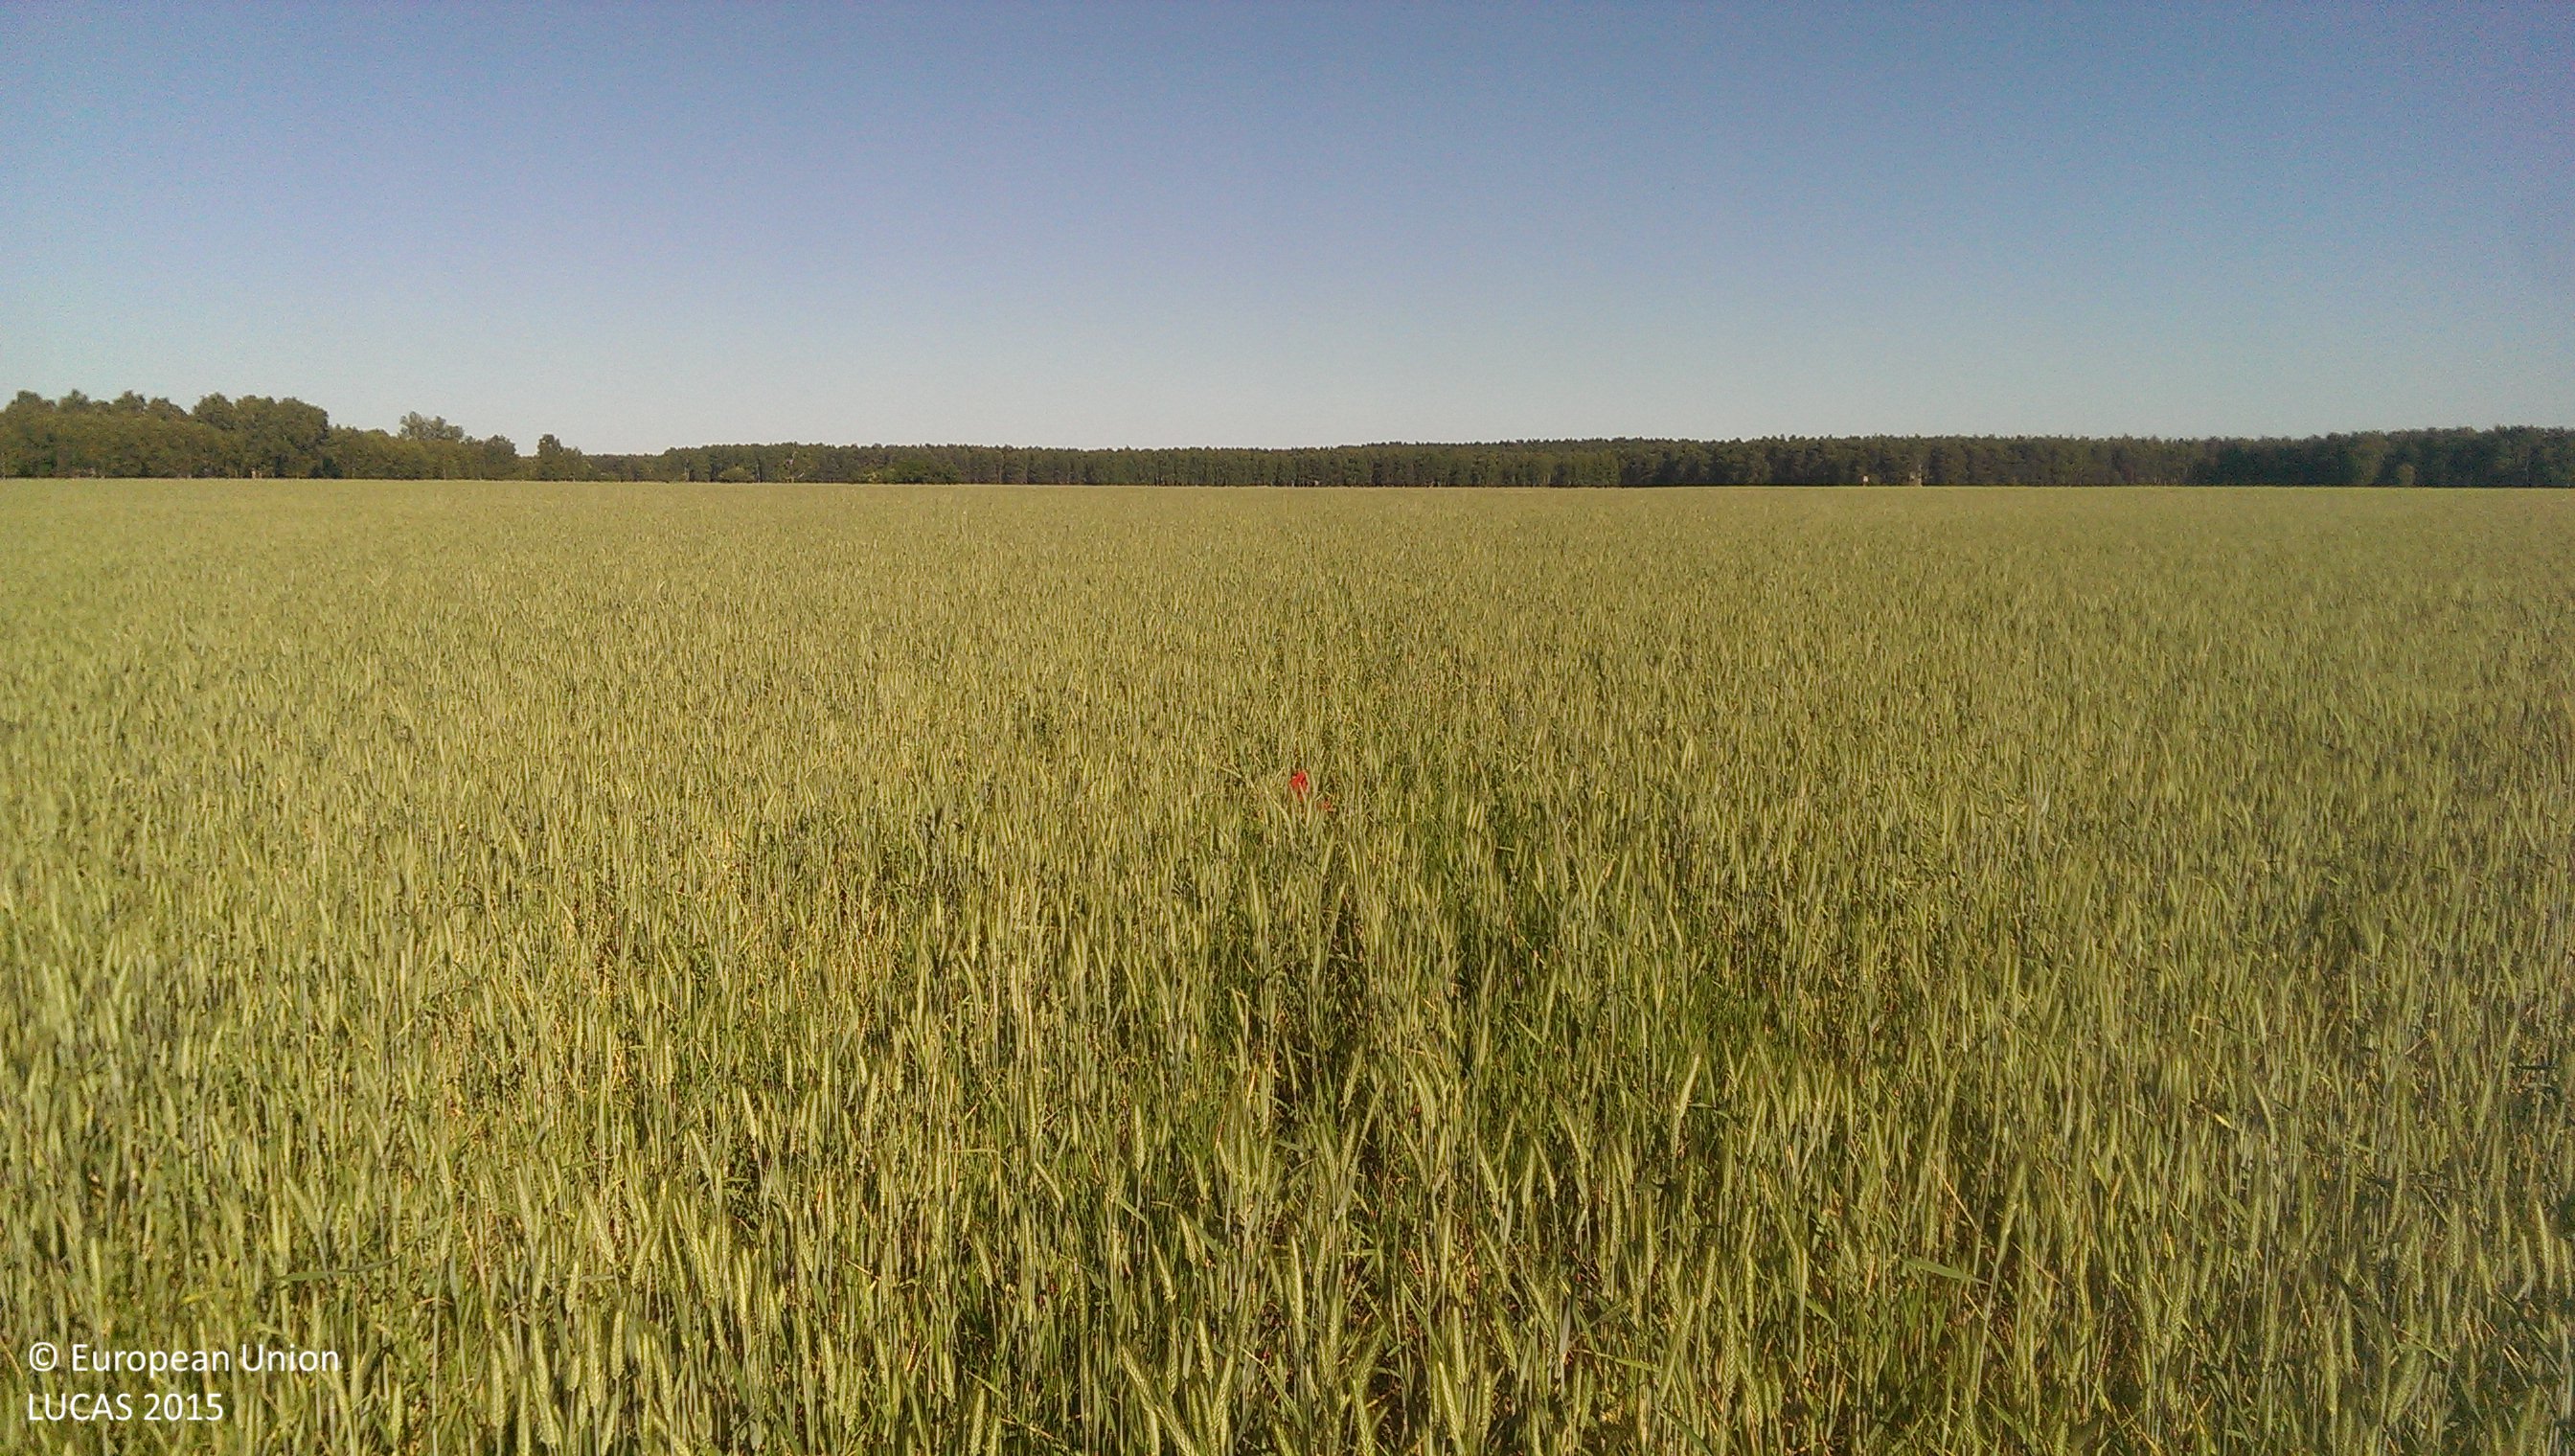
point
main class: Cropland
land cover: Triticale
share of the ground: > 75 %
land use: Agriculture (excluding fallow land and kitchen gardens)
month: June
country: PL
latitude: 51.8039
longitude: 16.1408
